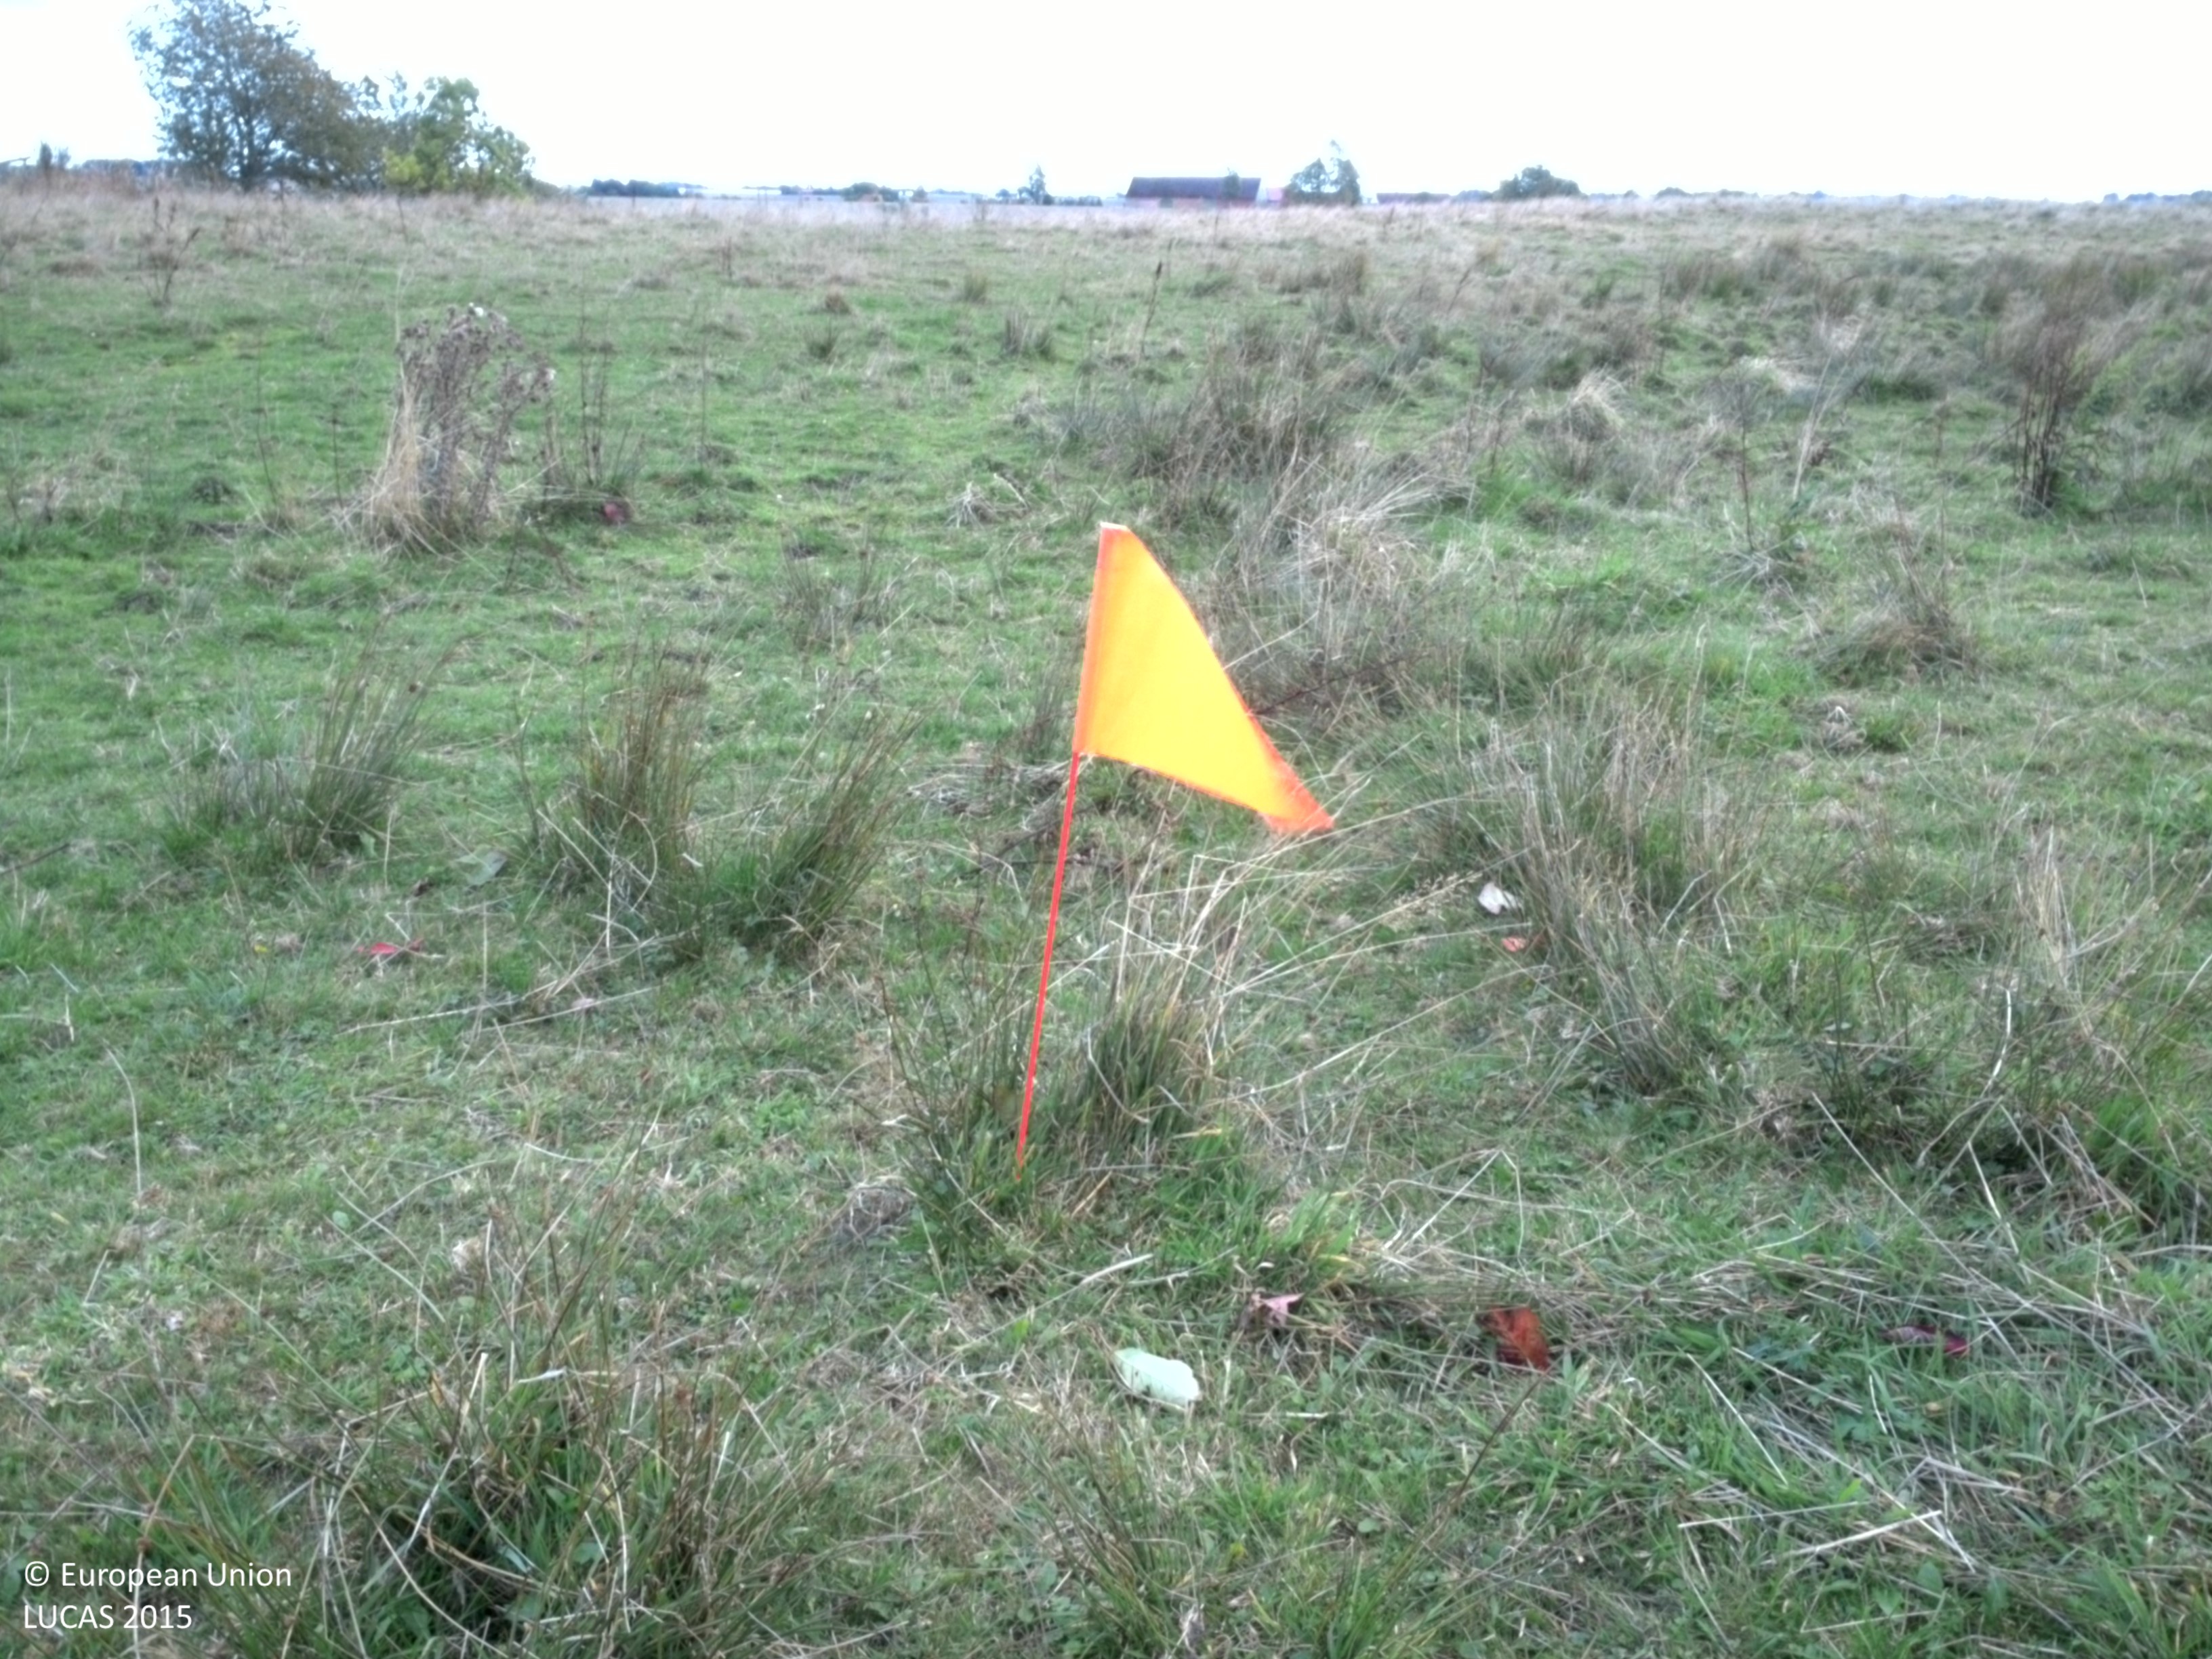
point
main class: Grassland
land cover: Grassland without tree/shrub cover
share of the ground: > 75 %
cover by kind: herbaceous plants 100 %
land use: Agriculture (excluding fallow land and kitchen gardens)
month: October
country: SE
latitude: 55.5631
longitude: 14.1370
